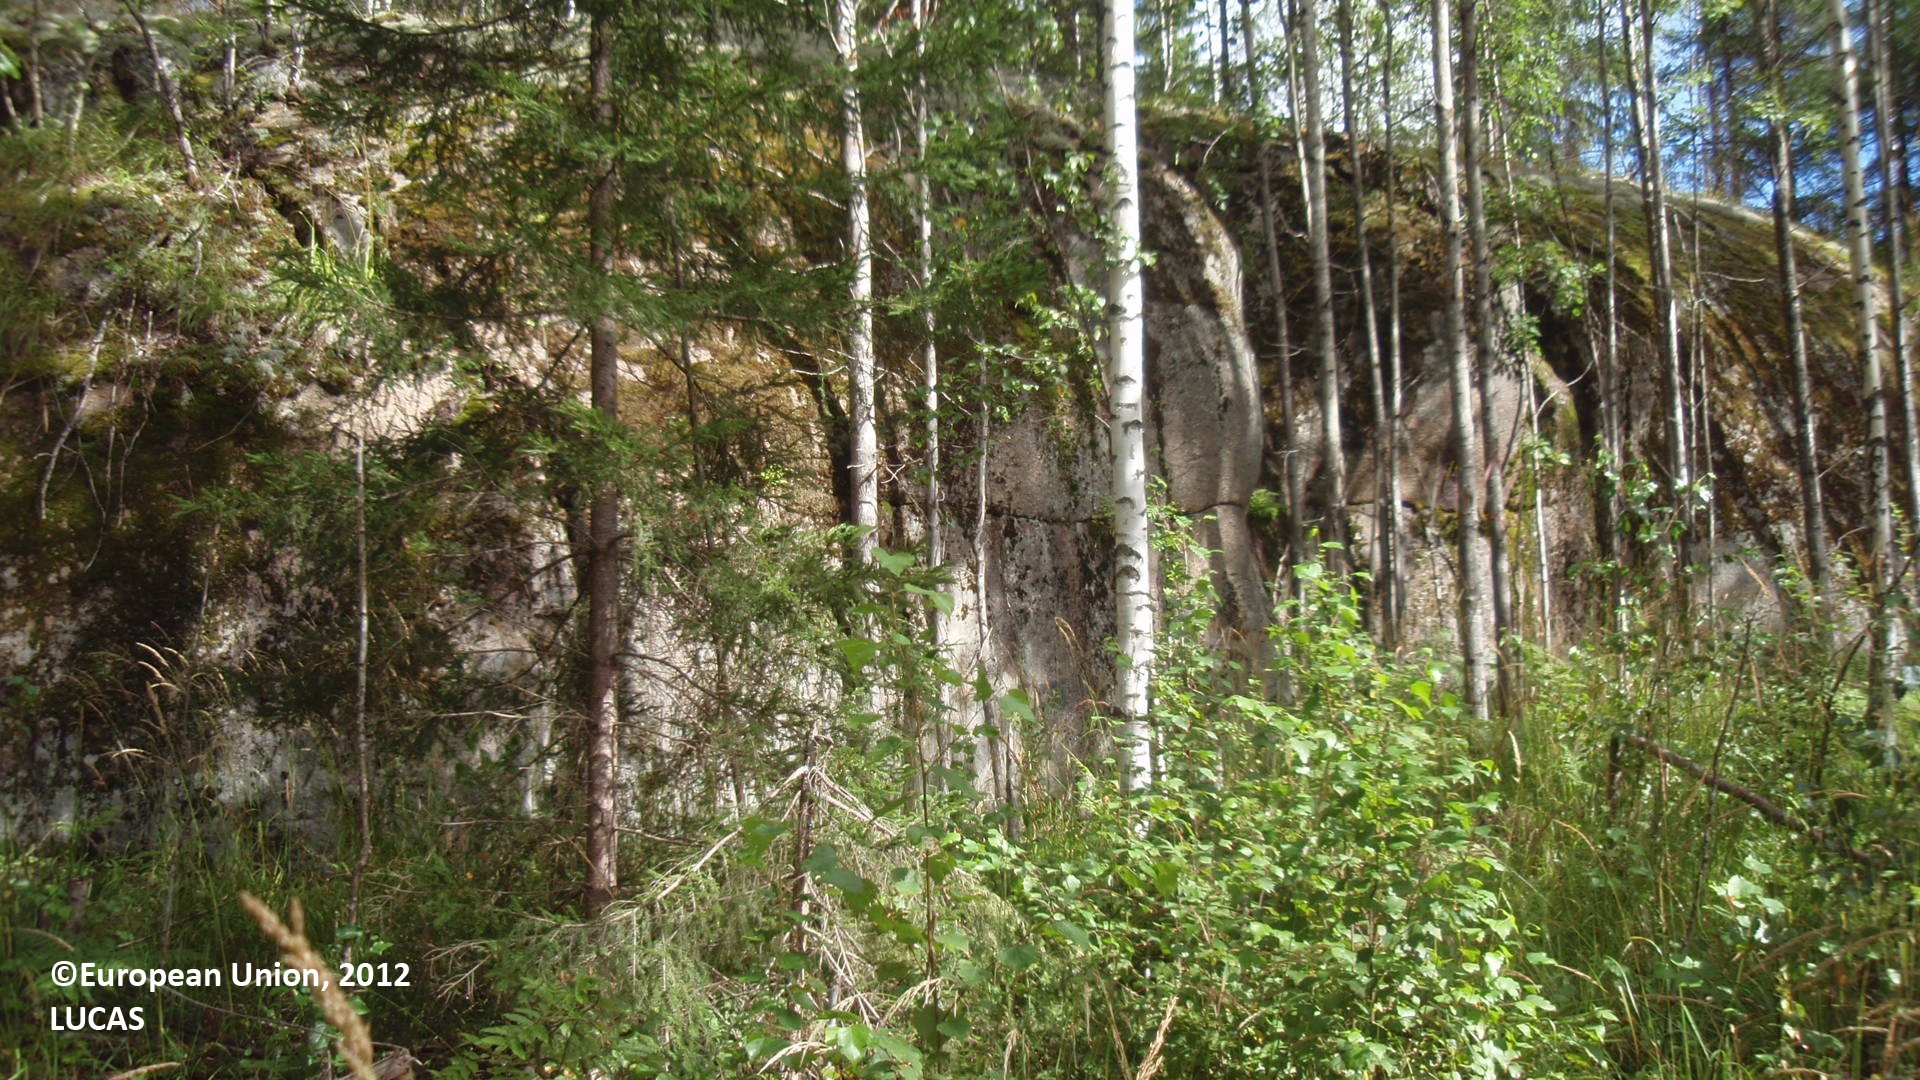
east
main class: Woodland
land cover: Pine dominated mixed woodland
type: boreal forest
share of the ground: 50 - 75 %
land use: Forestry
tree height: > 5 m
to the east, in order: Pine dominated mixed woodland; Rock outcrops; Other mixed woodland; Spruce dominated coniferous woodland; Tracks; Spruce dominated coniferous woodland; Grassland with sparse tree/shrub cover; Spruce dominated mixed woodland; Spruce dominated coniferous woodland
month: August
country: FI
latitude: 61.0113
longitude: 26.9419
